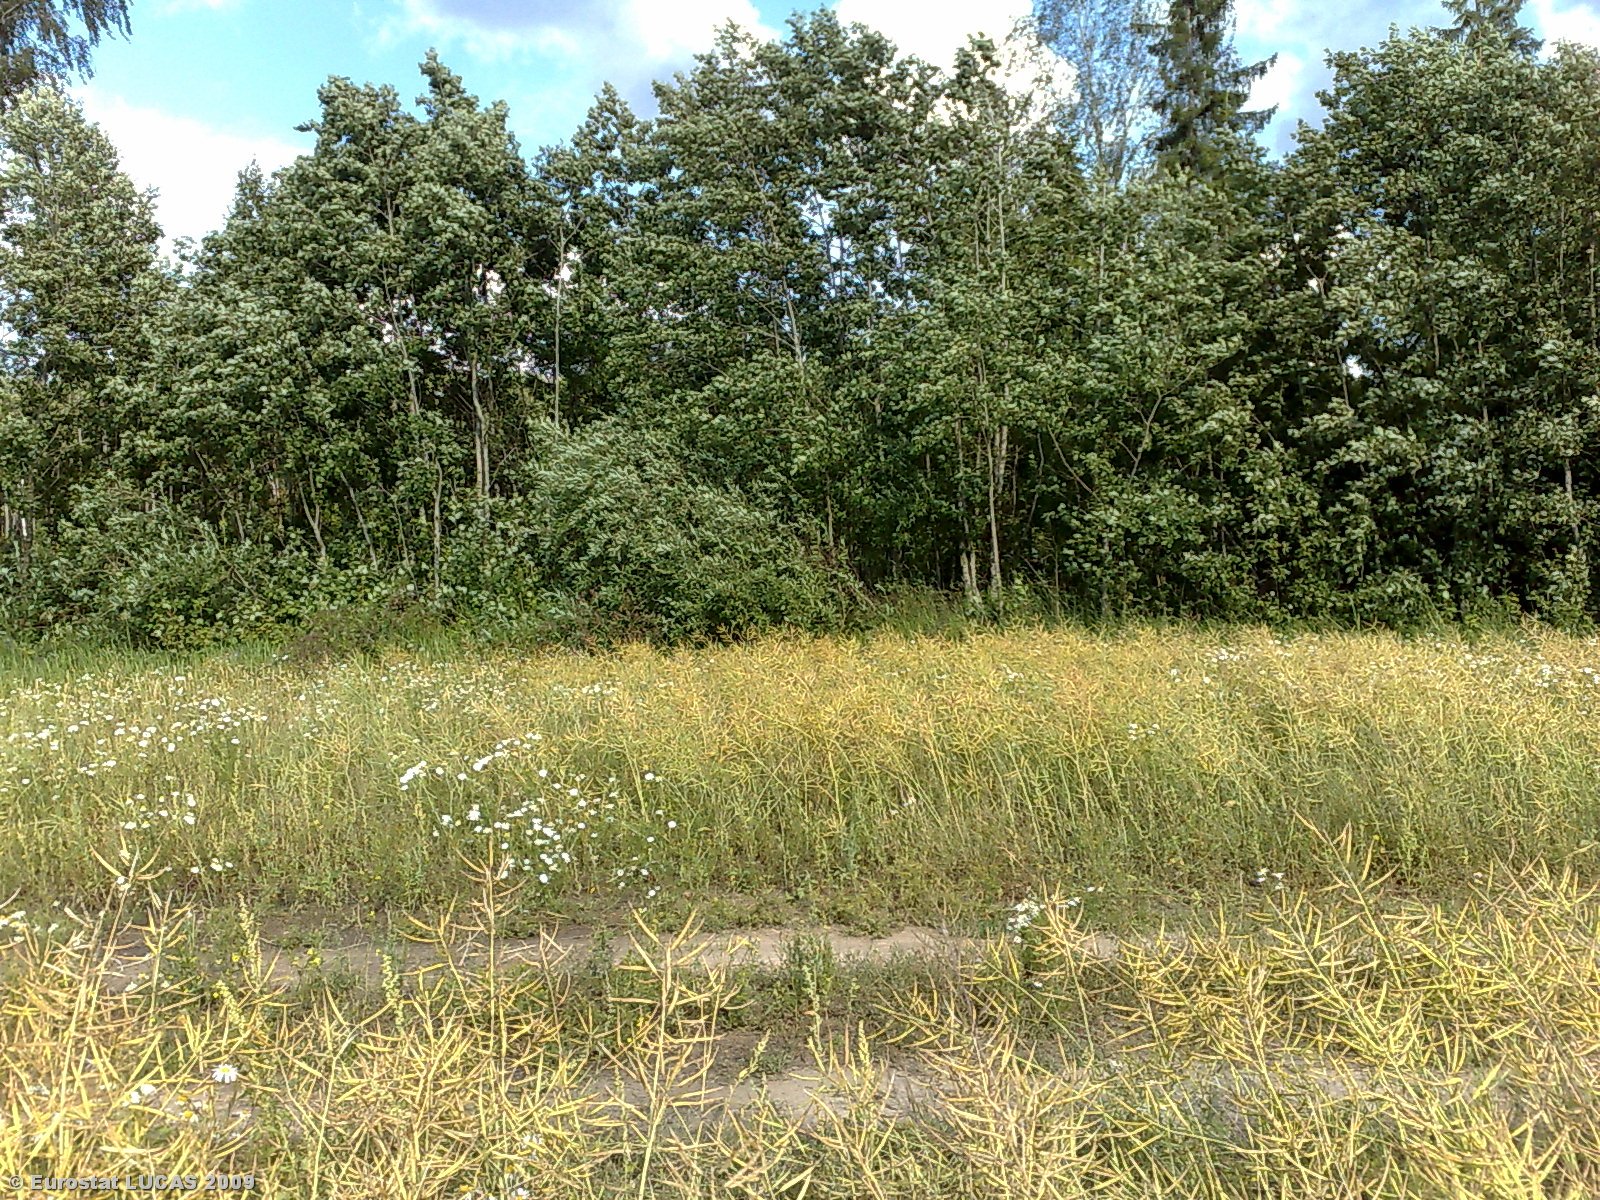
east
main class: Cropland
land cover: Rape and turnip rape
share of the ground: > 75 %
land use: Agriculture (excluding fallow land and kitchen gardens)
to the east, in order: Rape and turnip rape; Tracks; Rape and turnip rape; Grass margins; Abandoned hedges; Ditches and canals; Grassland with sparse tree/shrub cover
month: July
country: LT
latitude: 56.0829
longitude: 22.8724
